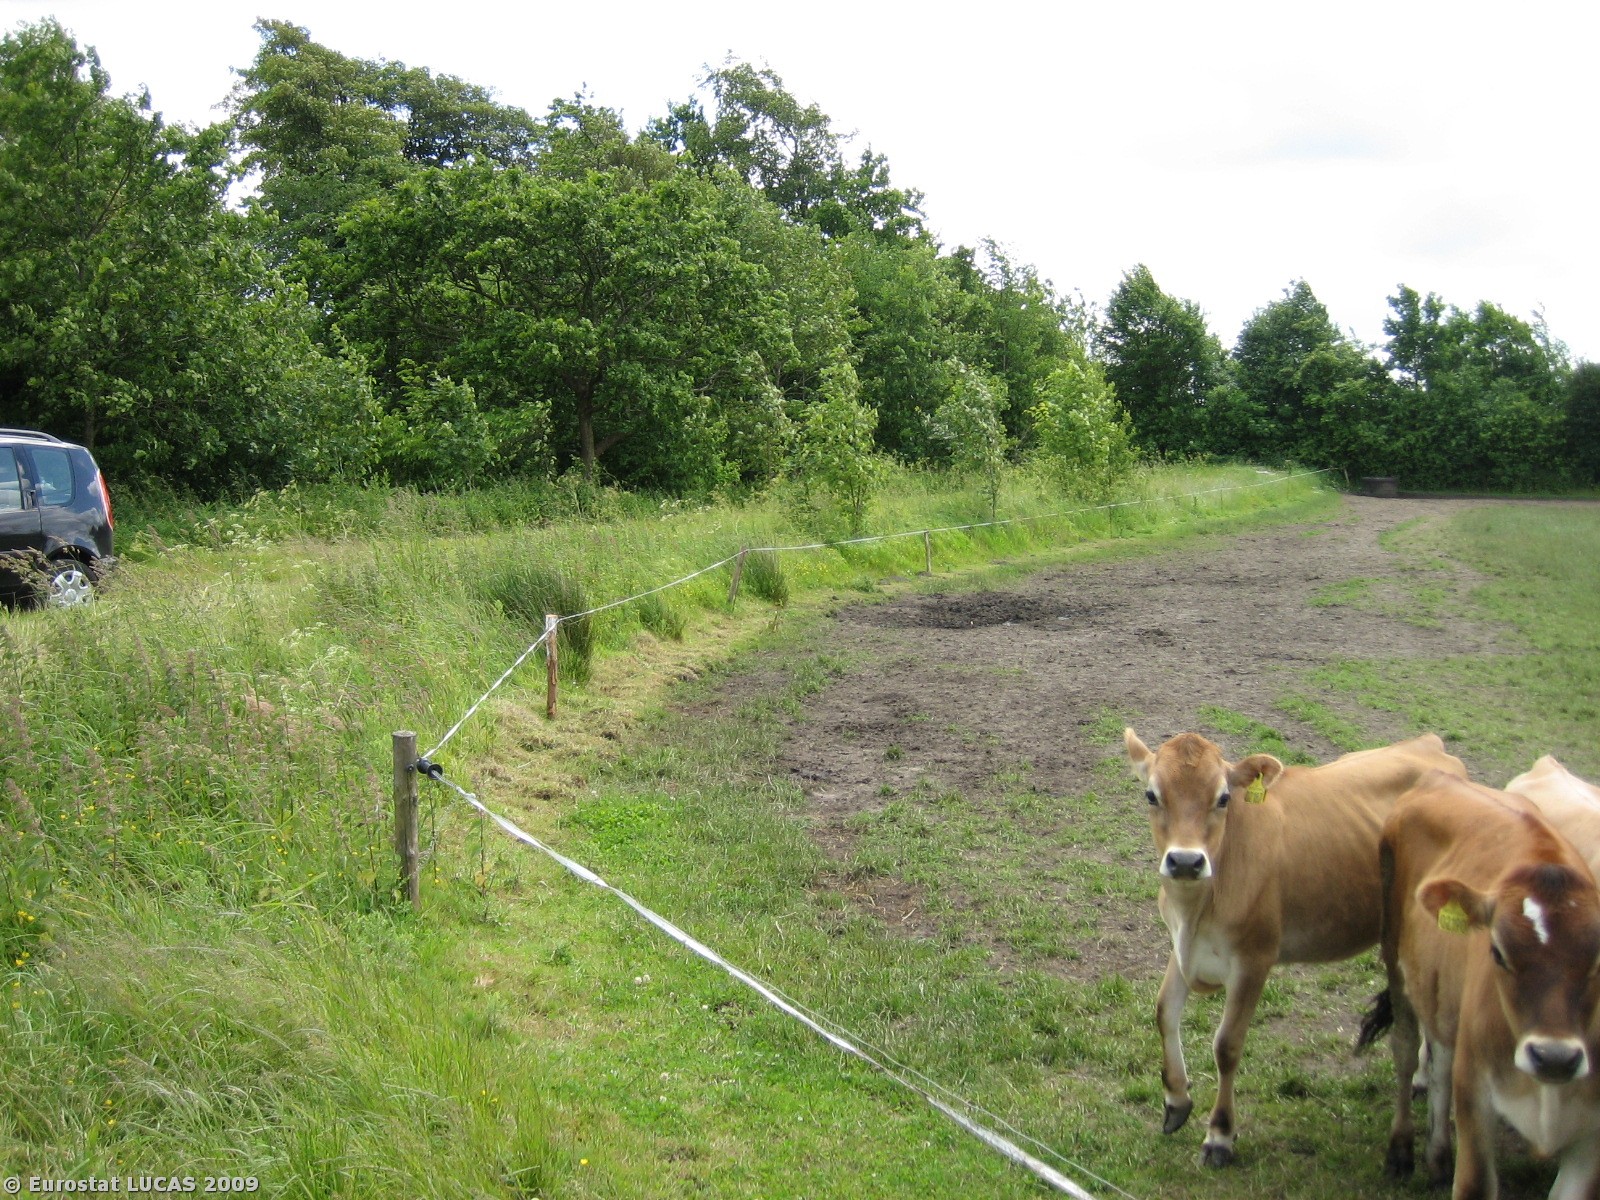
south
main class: Grassland
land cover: Grassland without tree/shrub cover
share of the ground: 10 - 25 %
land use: Agriculture (excluding fallow land and kitchen gardens)
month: June
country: DK
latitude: 55.7360
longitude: 9.2204
